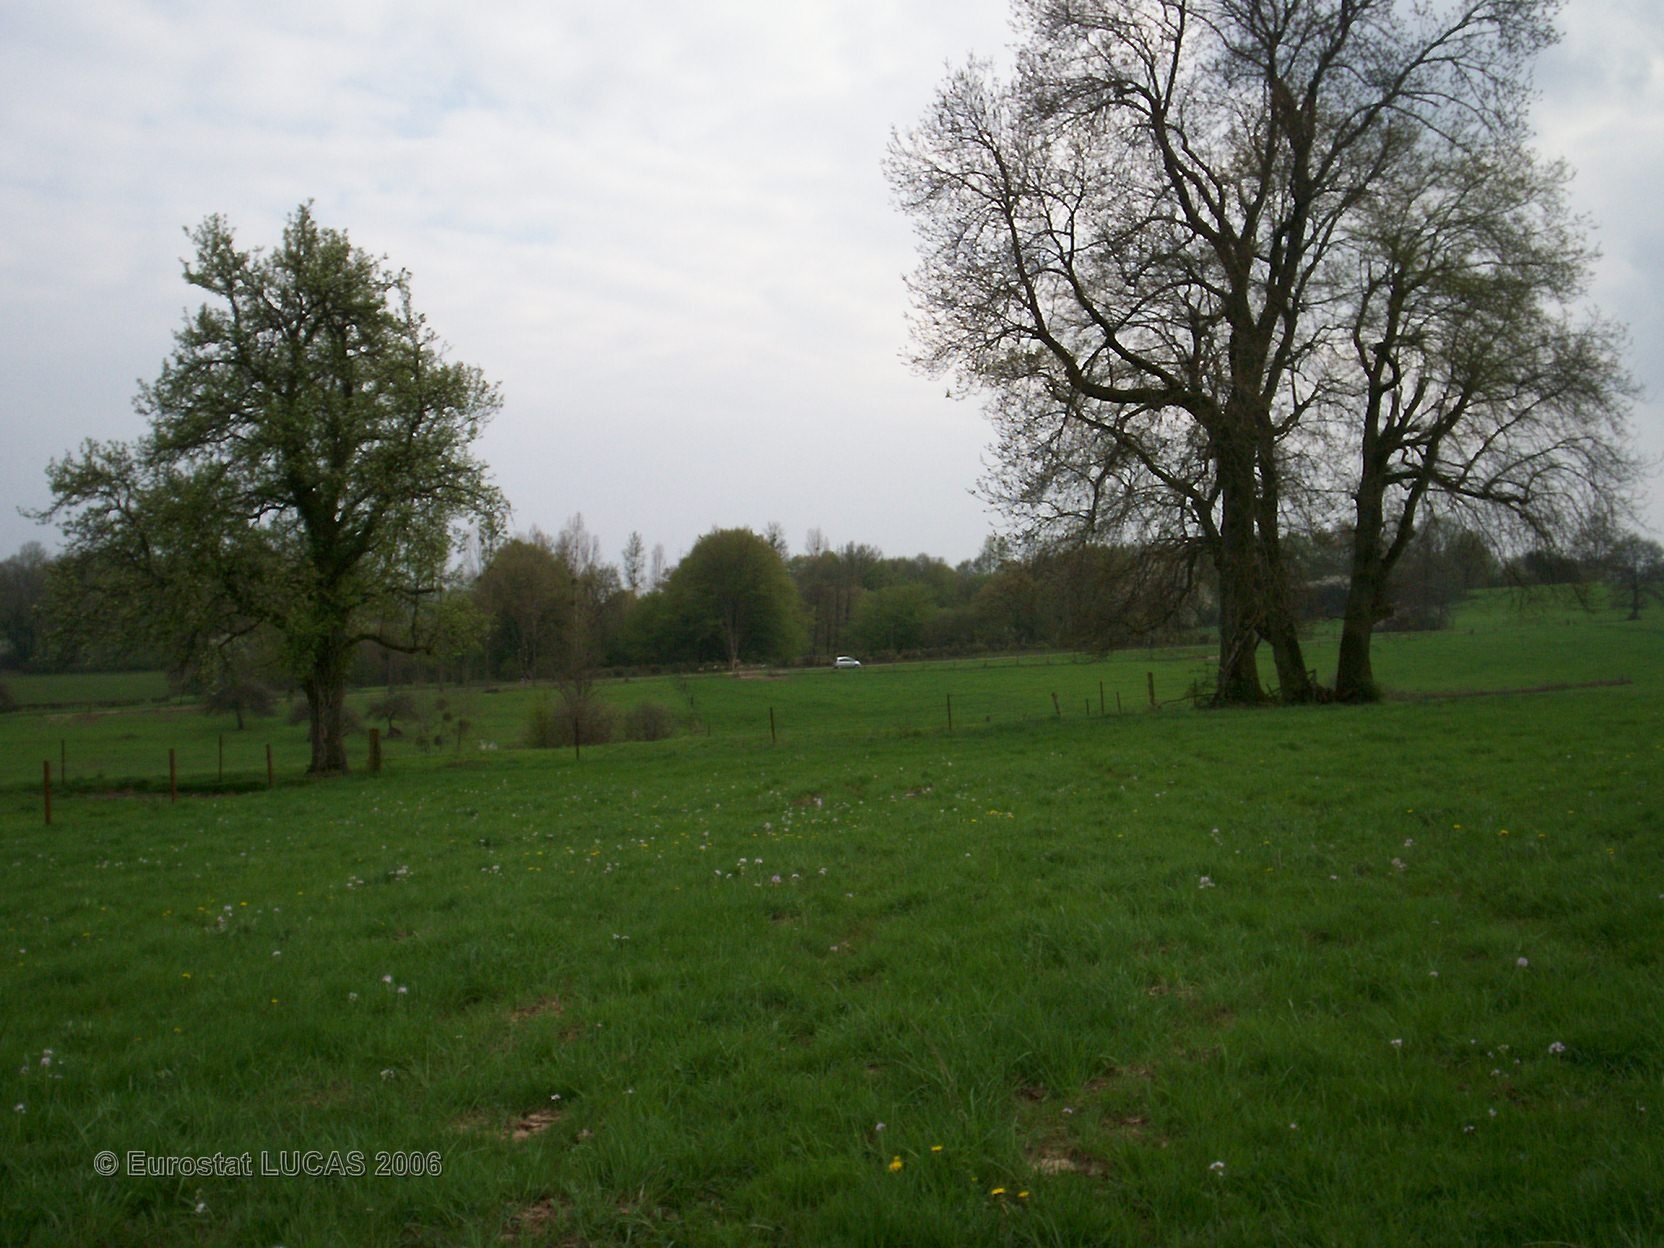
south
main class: Grassland
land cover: Grassland without tree/shrub cover
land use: Agriculture (excluding fallow land and kitchen gardens)
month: April
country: FR
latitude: 49.7045
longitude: 4.4079
